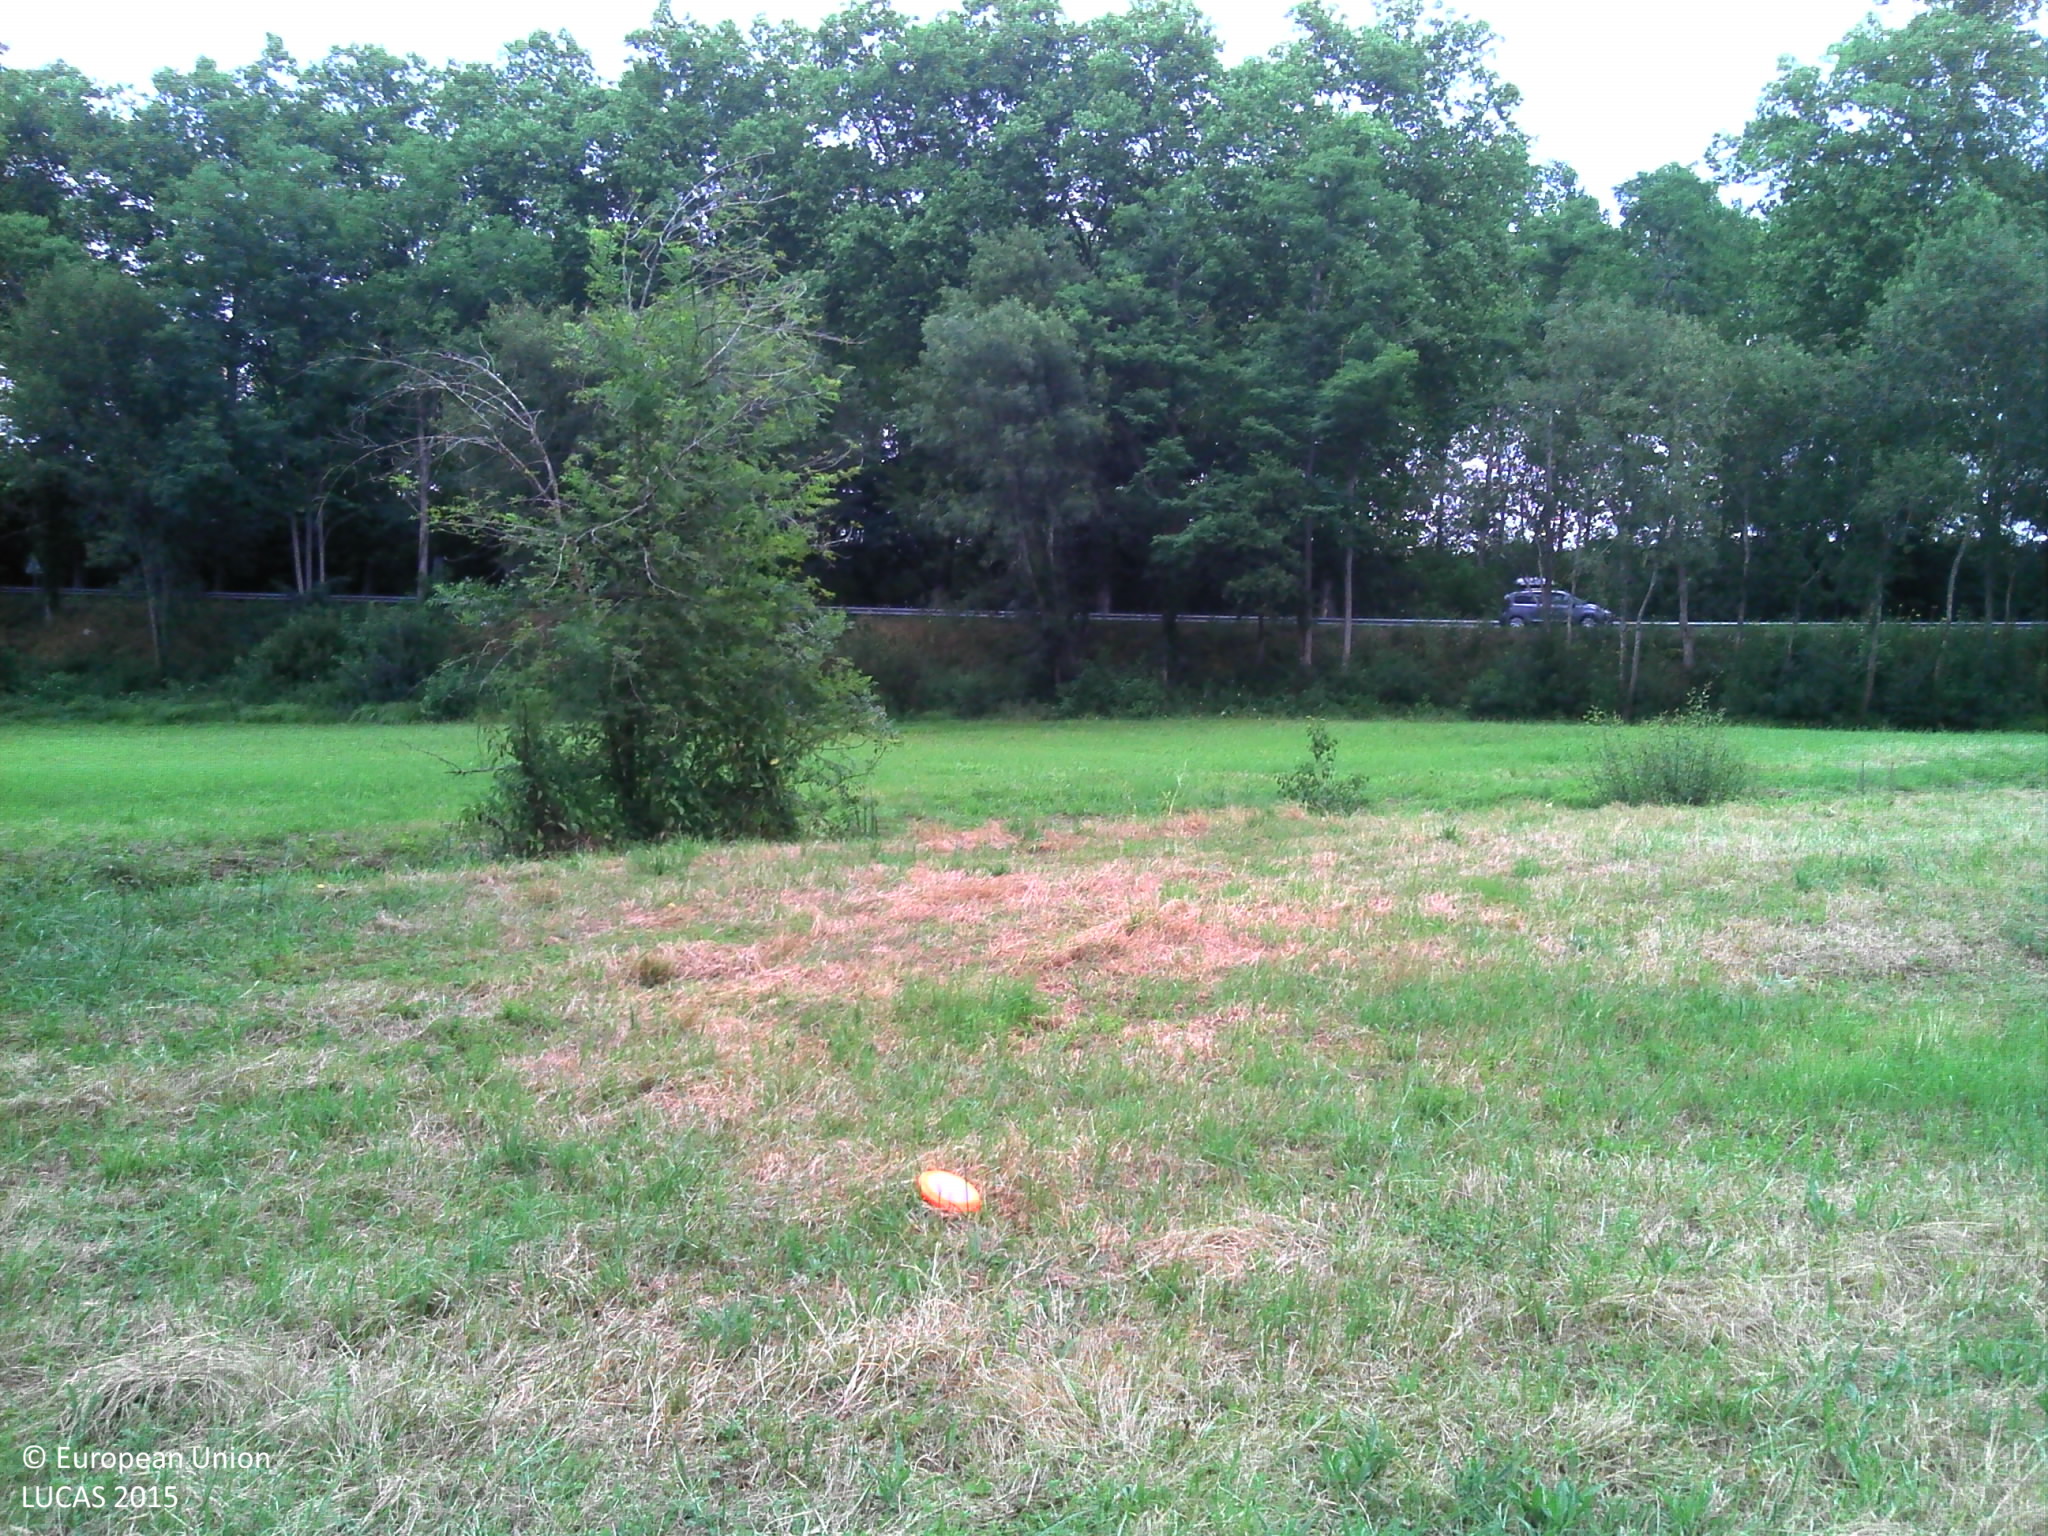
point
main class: Grassland
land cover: Grassland without tree/shrub cover
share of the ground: > 75 %
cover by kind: herbaceous plants 100 %
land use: Agriculture (excluding fallow land and kitchen gardens)
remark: Harvested field
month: July
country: FR
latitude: 43.6526
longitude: -1.1879
